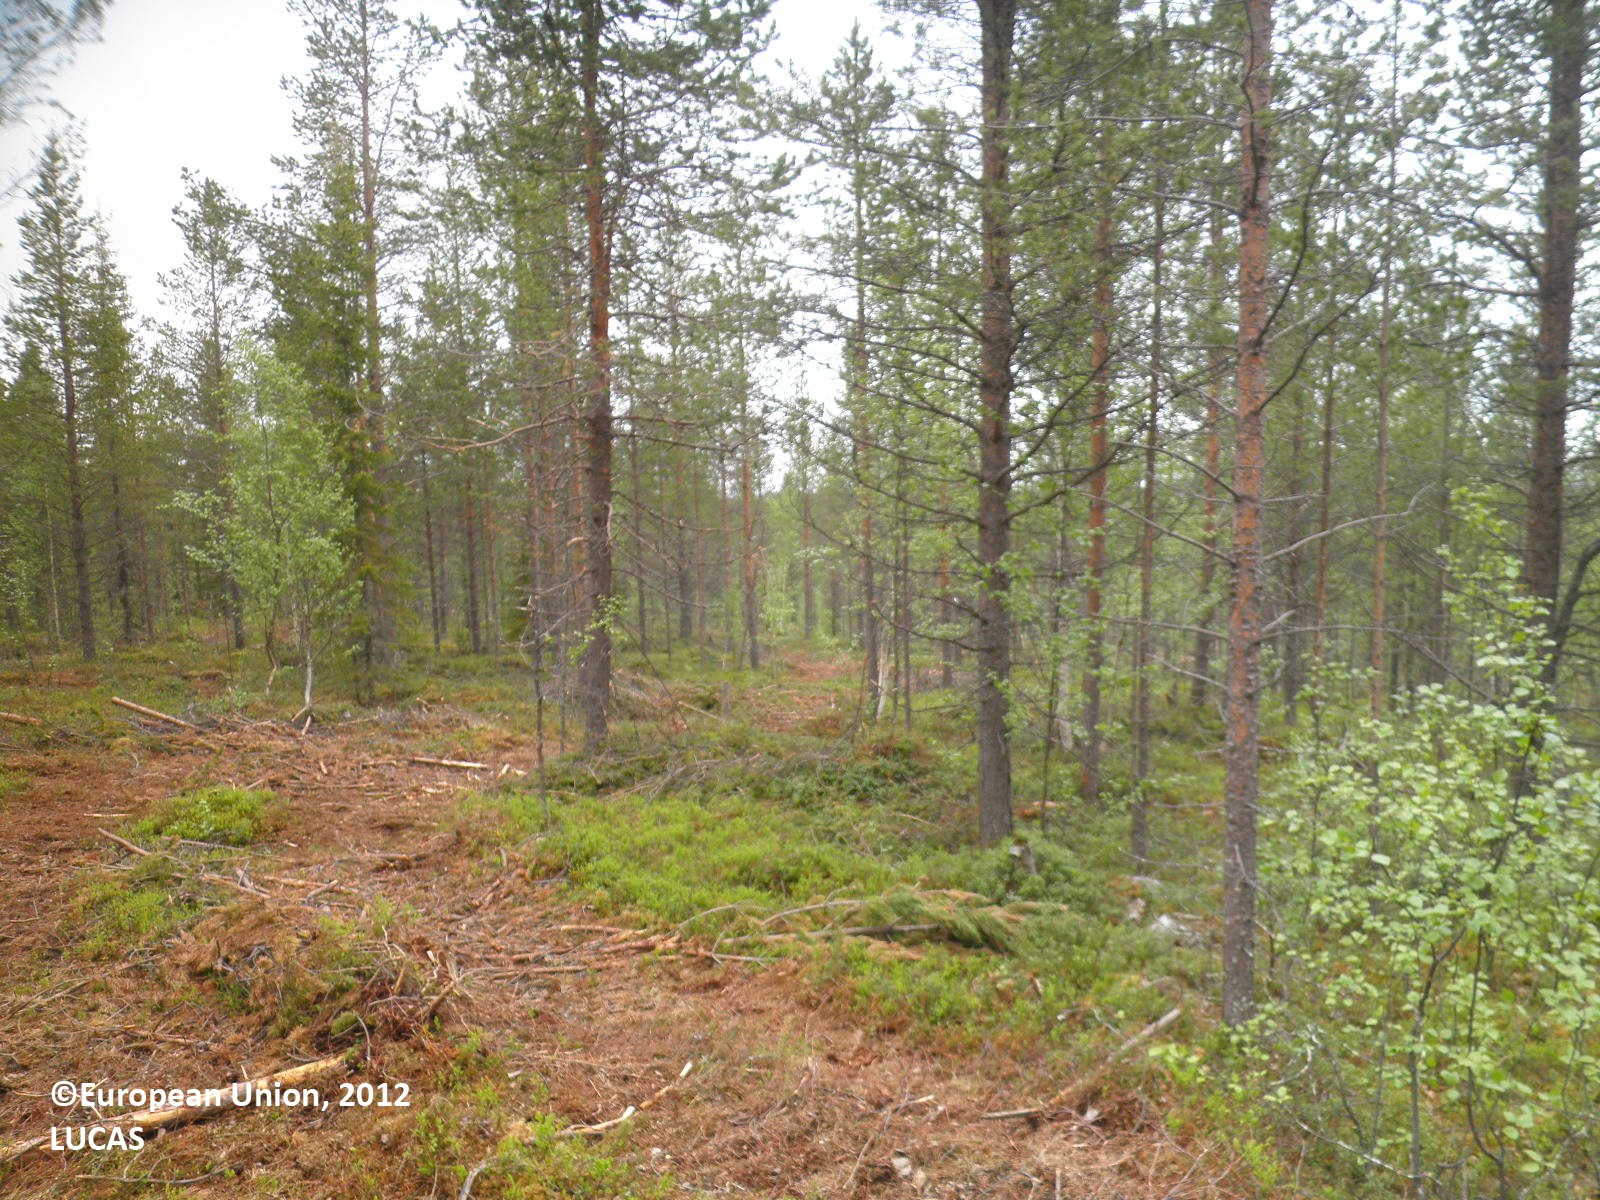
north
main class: Woodland
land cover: Pine dominated coniferous woodland
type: boreal forest
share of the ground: 25 - 50 %
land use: Forestry
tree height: > 5 m
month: June
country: FI
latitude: 67.8137
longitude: 25.5408
